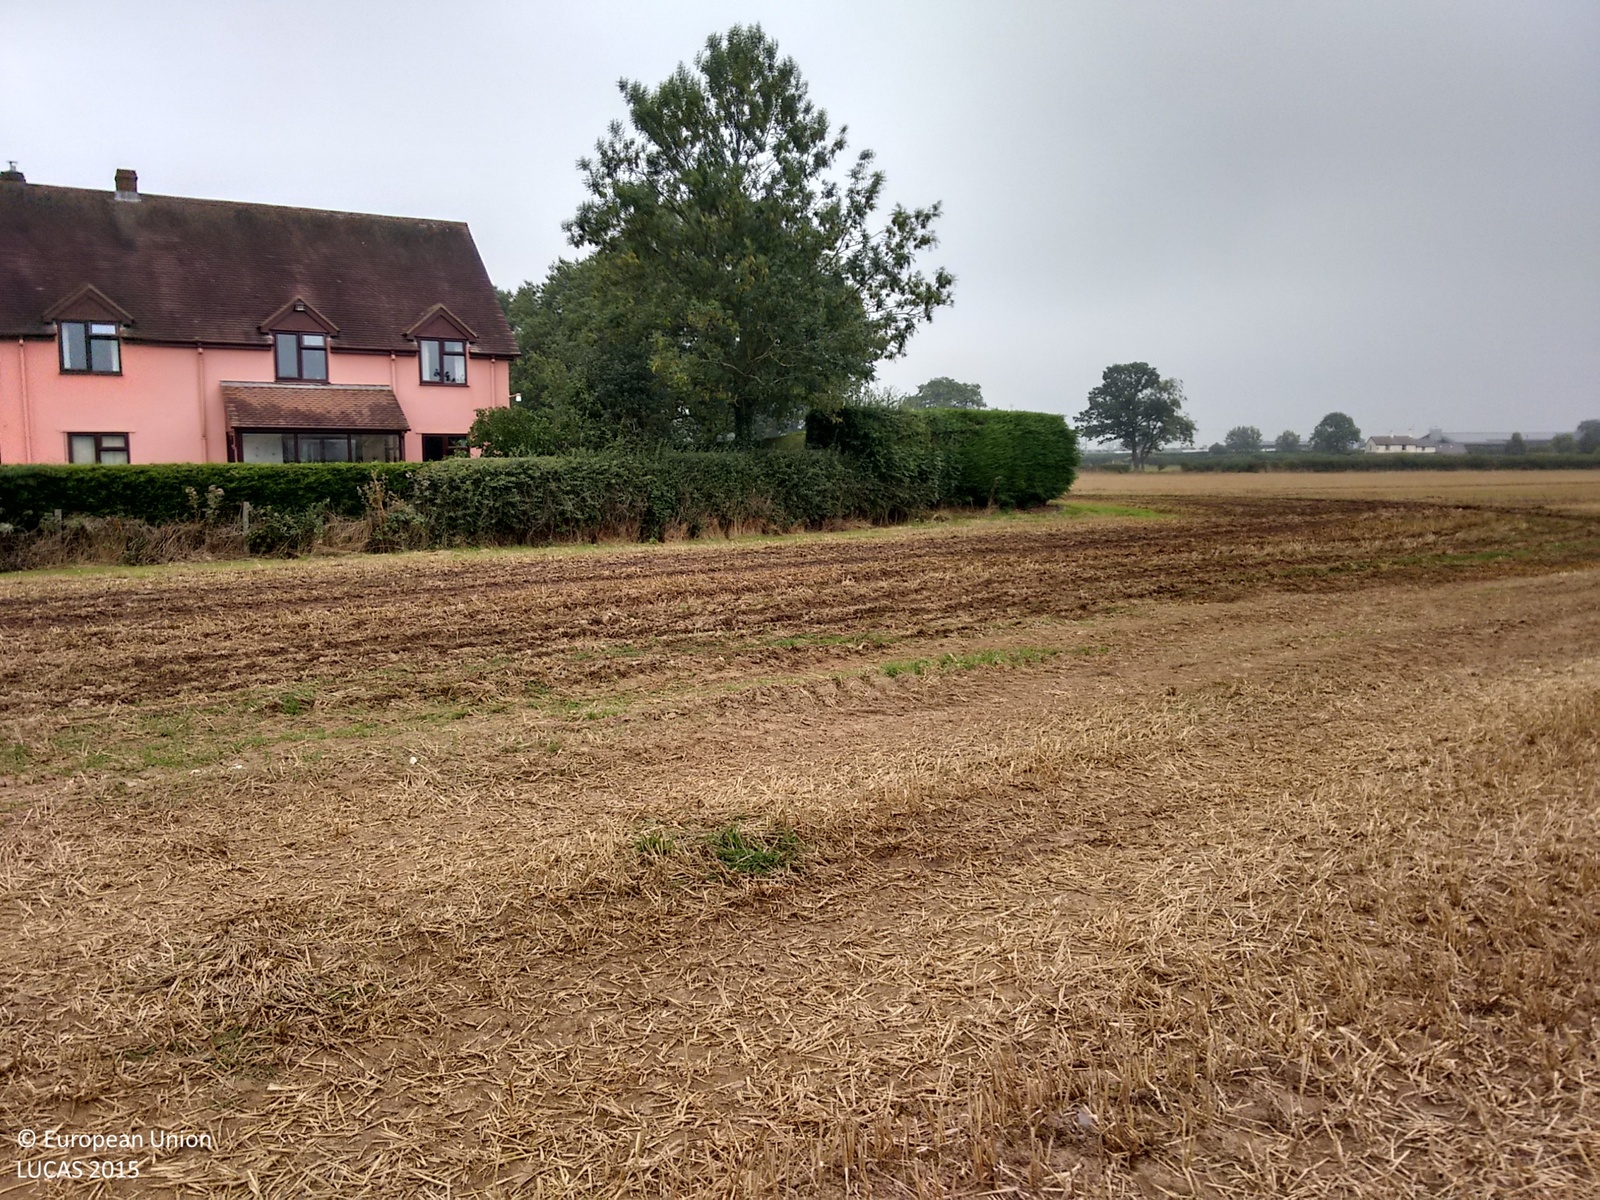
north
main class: Cropland
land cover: Common wheat
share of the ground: < 10 %
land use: Agriculture (excluding fallow land and kitchen gardens)
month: September
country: GB
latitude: 52.6868
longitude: -2.9293
